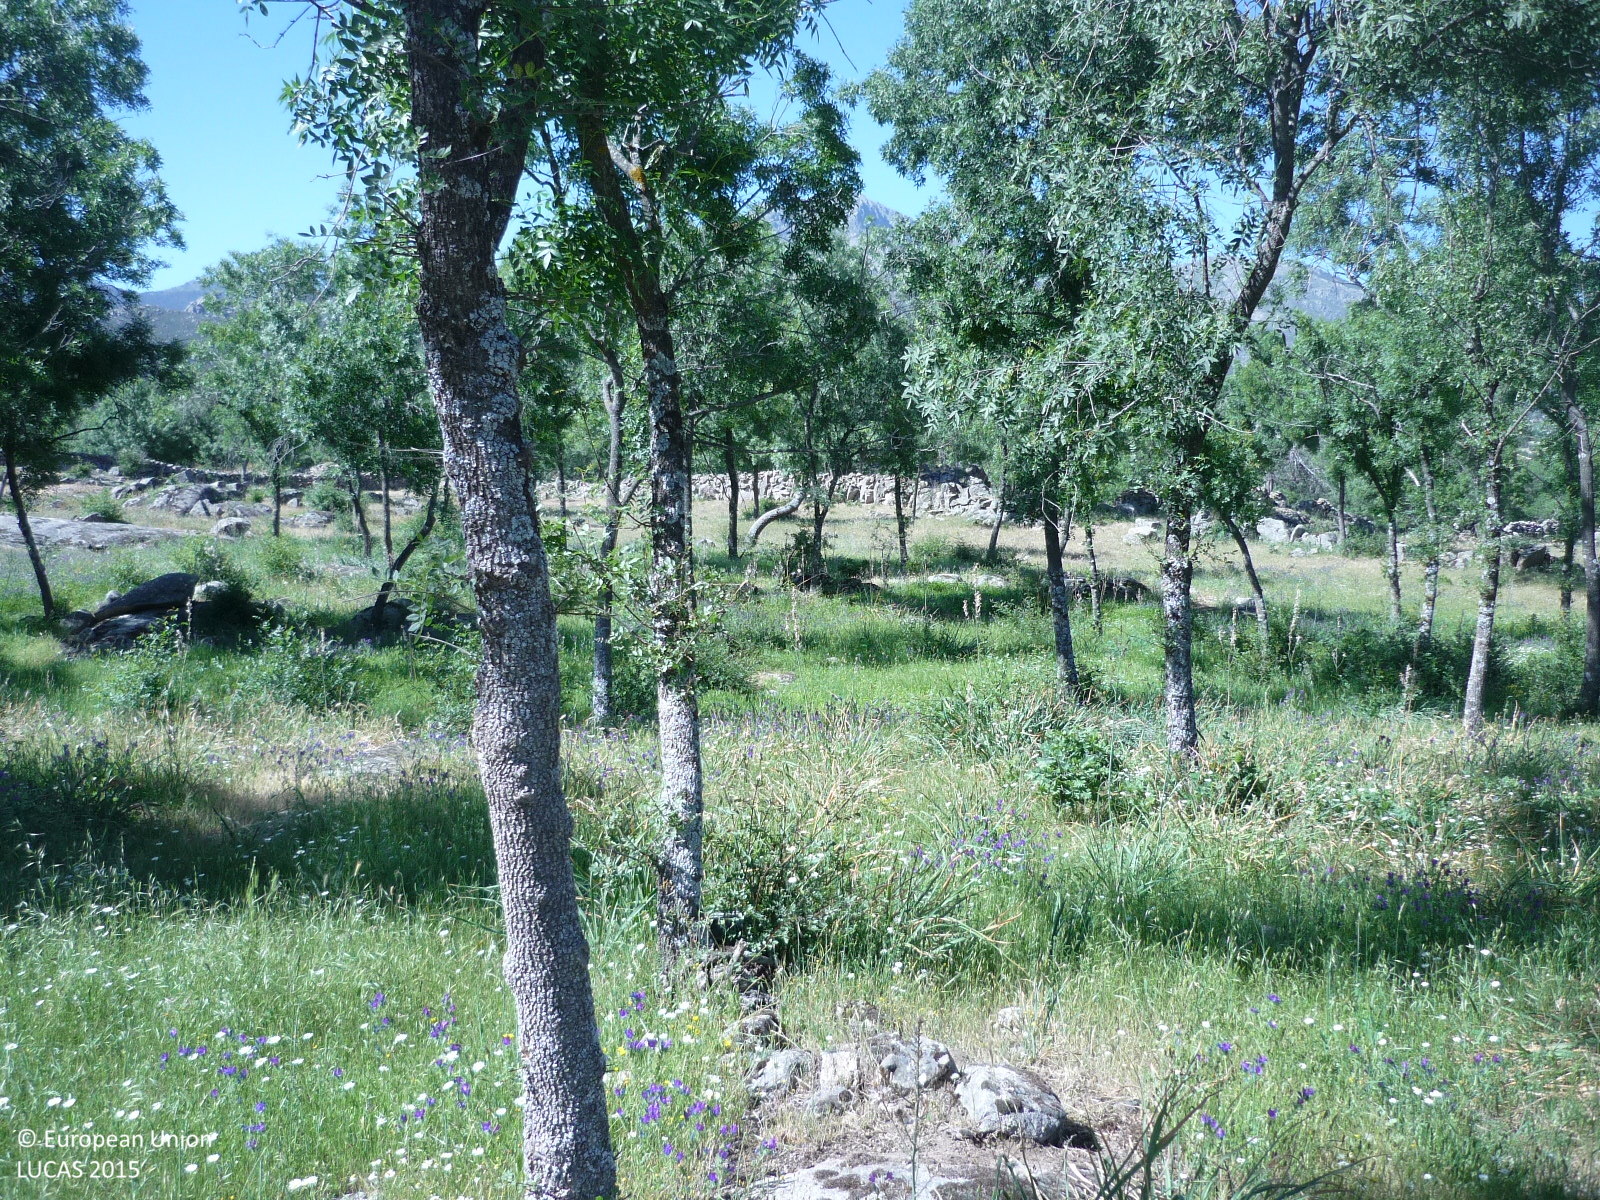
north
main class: Woodland
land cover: Broadleaved woodland
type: thermophilous deciduous forest
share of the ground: 50 - 75 %
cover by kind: broadleaved forest trees 70 %, herbaceous plants 20 %, shrubs 10 %
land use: Forestry
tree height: < 5 m
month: May
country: ES
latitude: 40.7091
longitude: -3.9768
